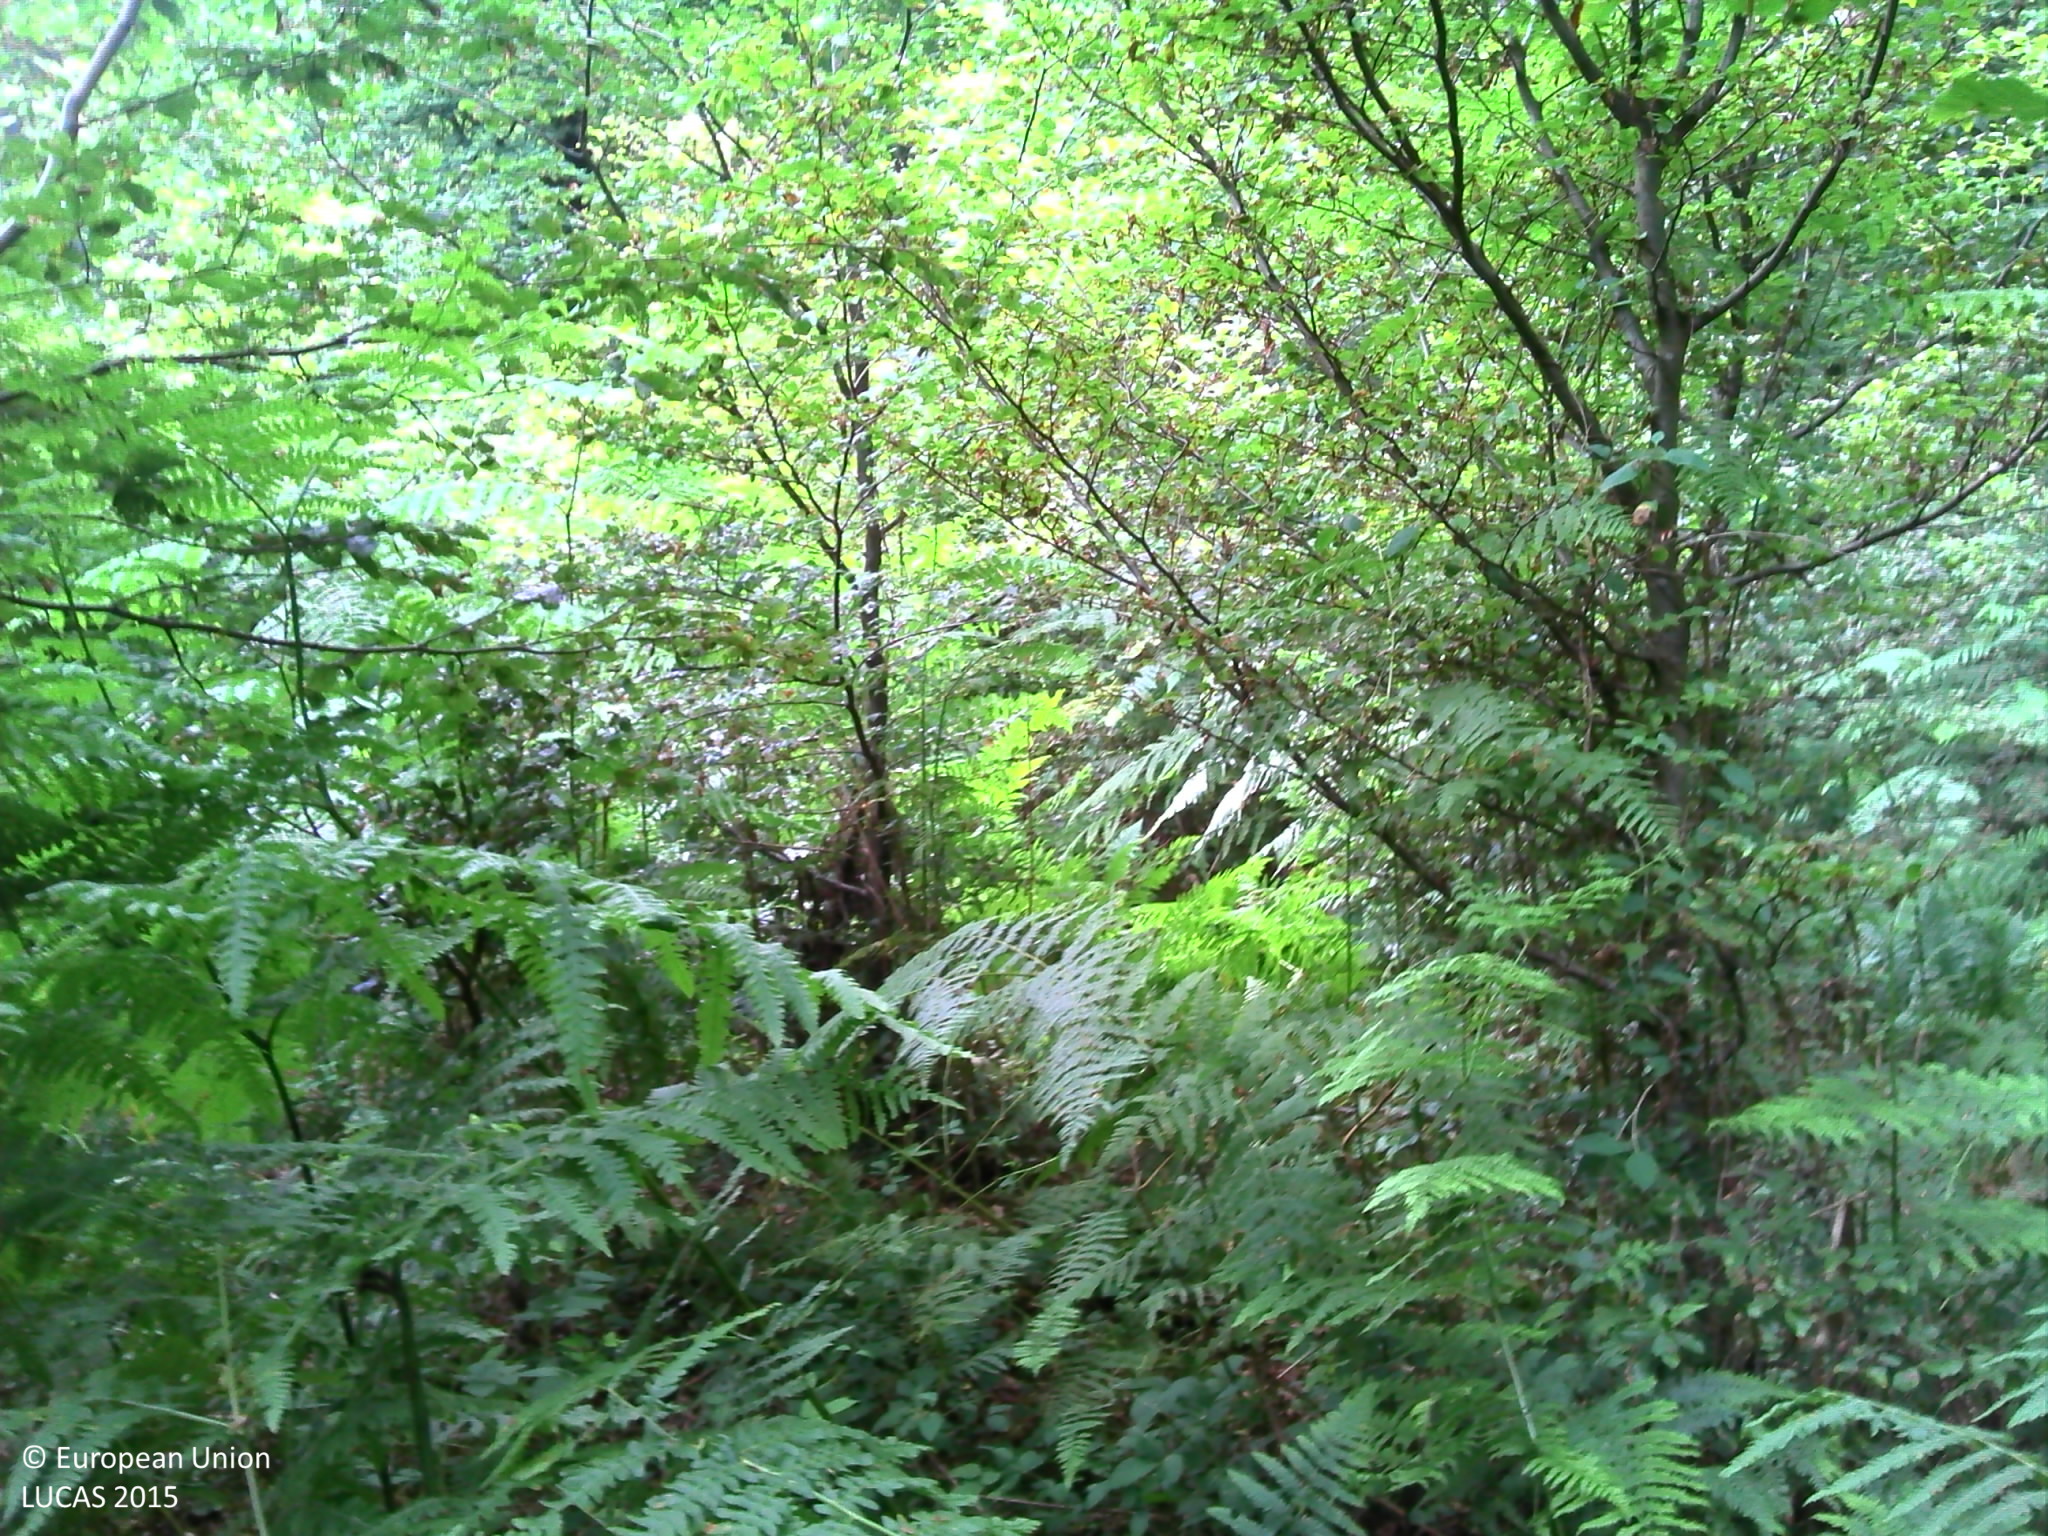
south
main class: Woodland
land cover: Broadleaved woodland
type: beech forest
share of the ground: 50 - 75 %
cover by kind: broadleaved forest trees 70 %, herbaceous plants 30 %
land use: Forestry
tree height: > 5 m
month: July
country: BE
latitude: 49.6146
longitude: 5.6390
